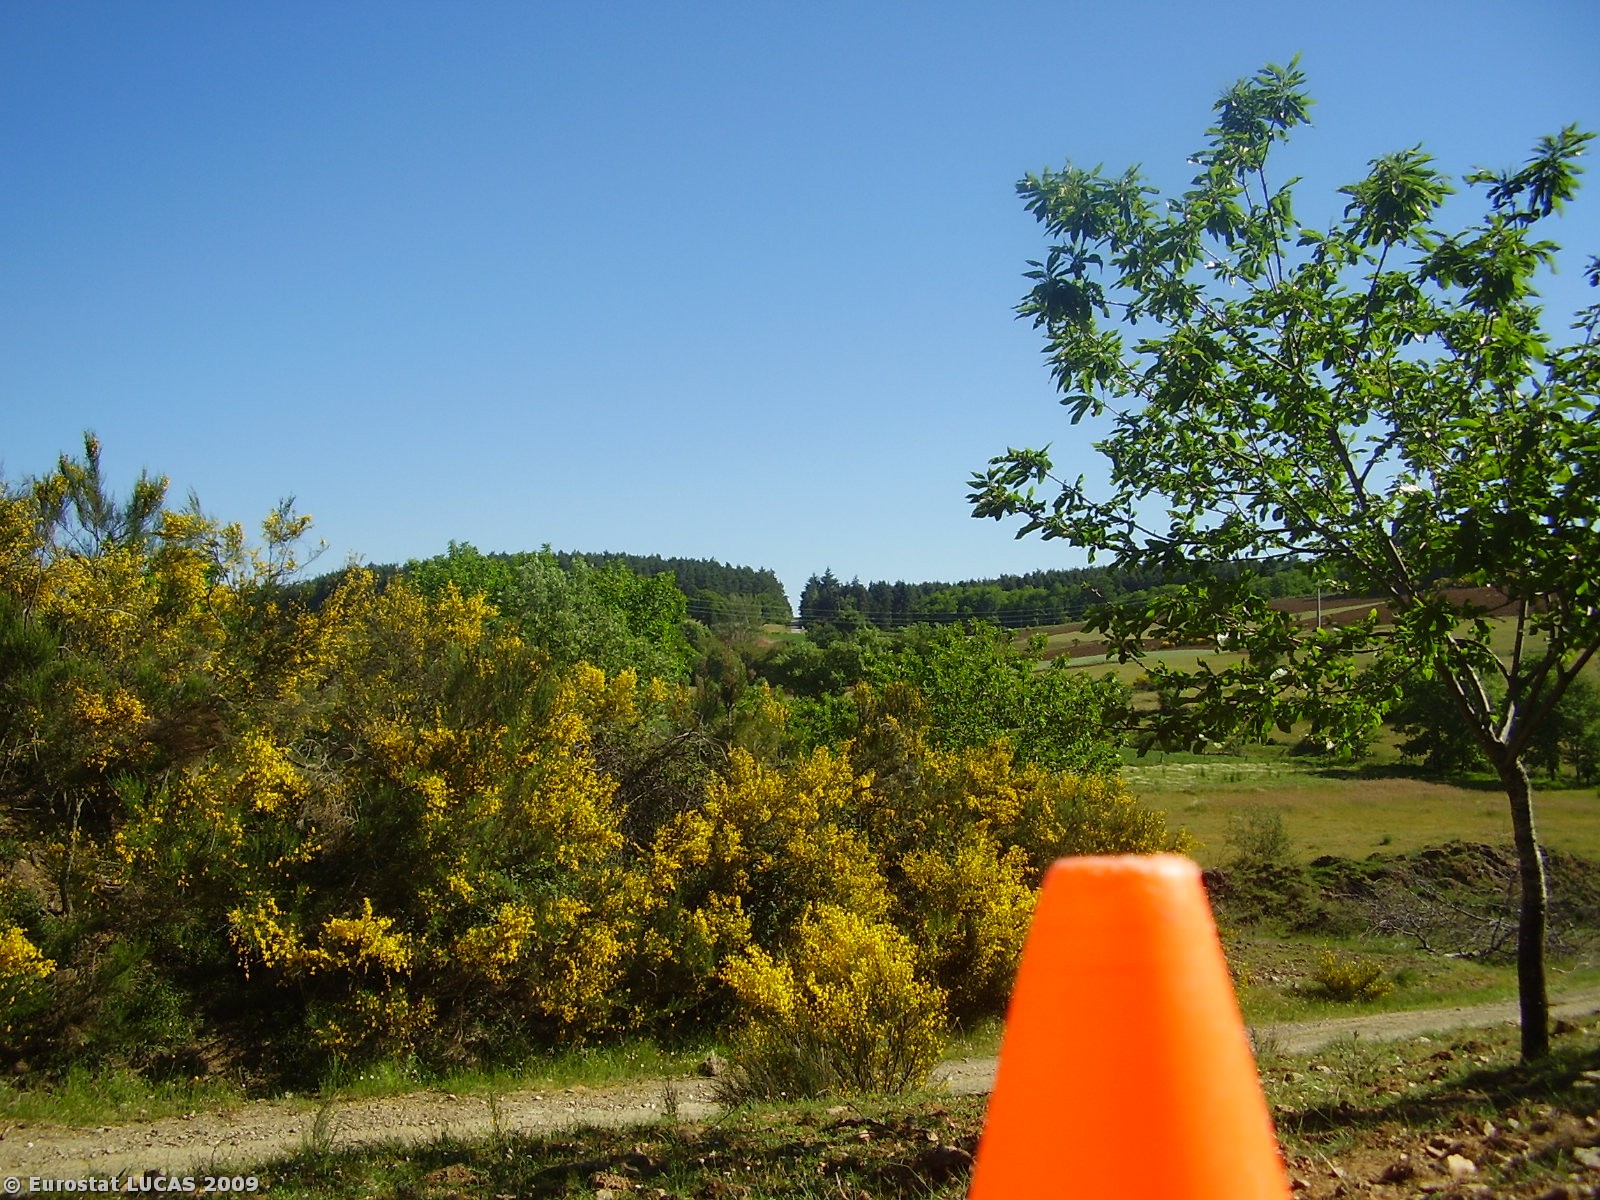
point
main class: Cropland
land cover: Other fruit trees and berries
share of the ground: 10 - 25 %
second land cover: Spontaneously vegetated surfaces
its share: < 10 %
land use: Agriculture (excluding fallow land and kitchen gardens)
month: June
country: PT
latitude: 41.7528
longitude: -6.9171
